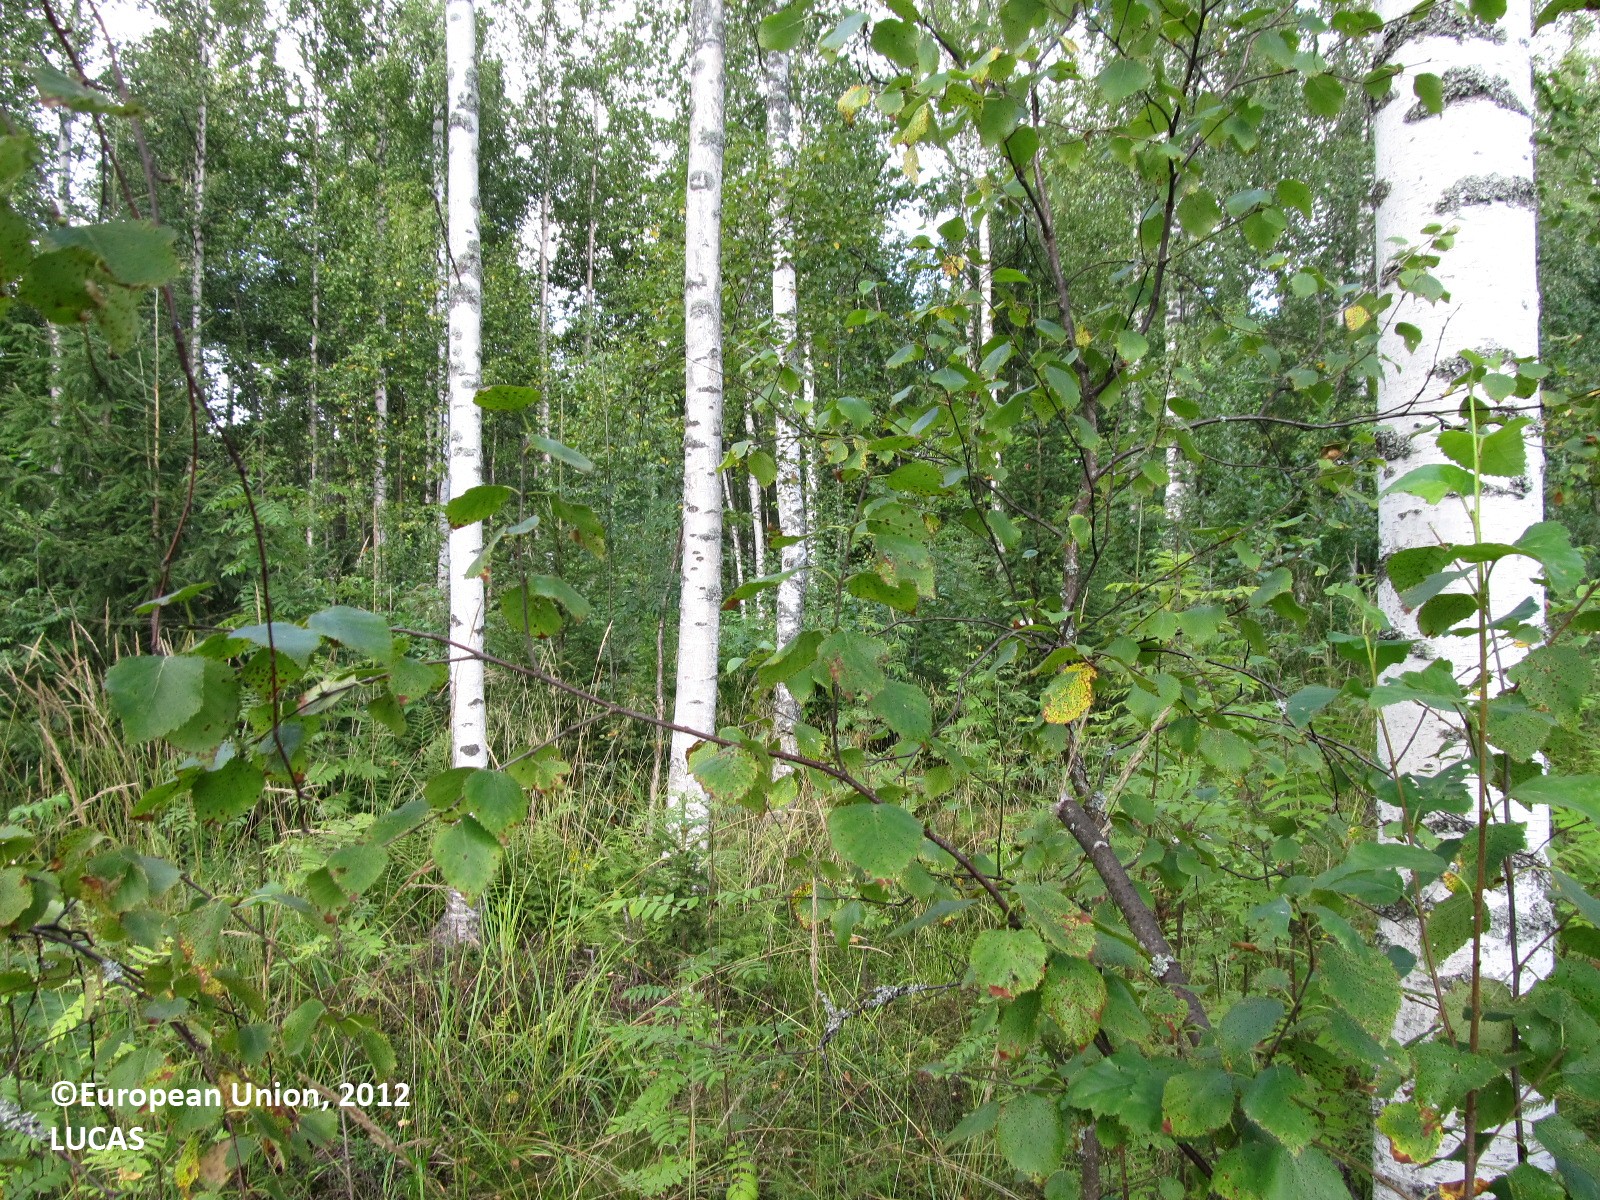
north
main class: Woodland
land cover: Broadleaved woodland
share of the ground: 25 - 50 %
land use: Forestry
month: August
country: FI
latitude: 62.3235
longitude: 27.5990
